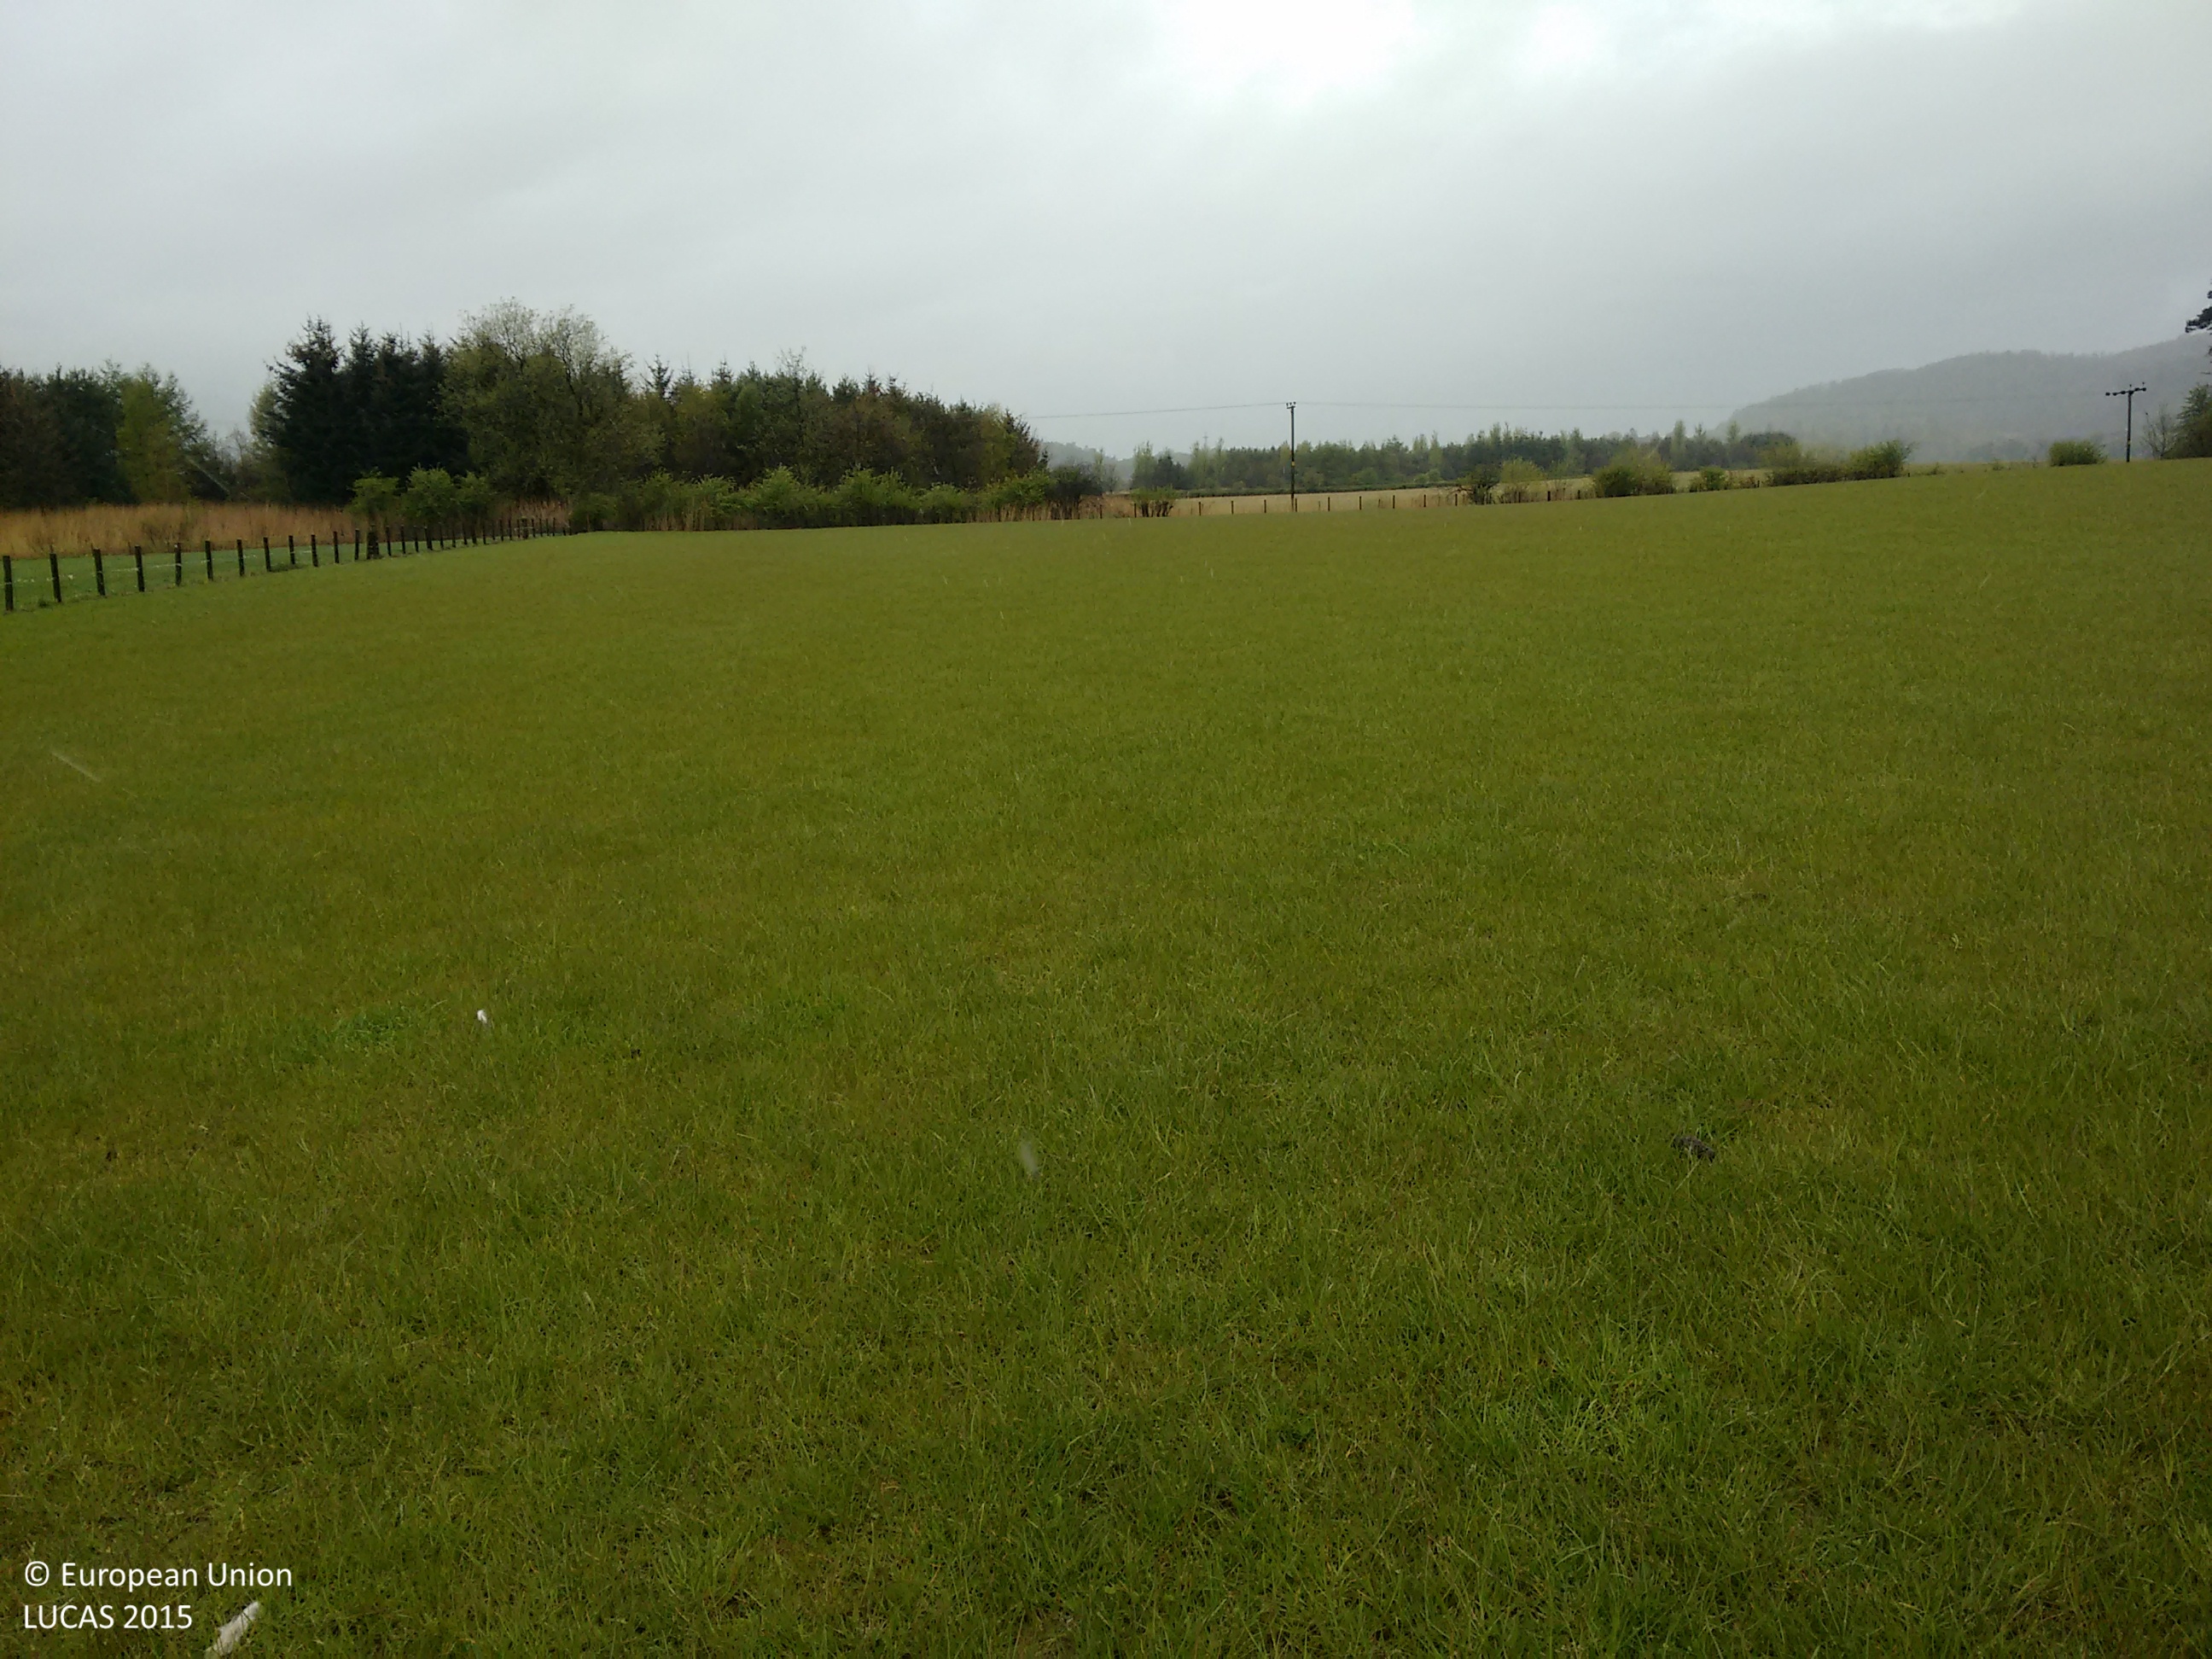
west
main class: Grassland
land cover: Grassland without tree/shrub cover
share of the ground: > 75 %
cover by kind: herbaceous plants 100 %
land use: Agriculture (excluding fallow land and kitchen gardens)
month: May
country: GB
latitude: 56.1416
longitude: -3.8764
